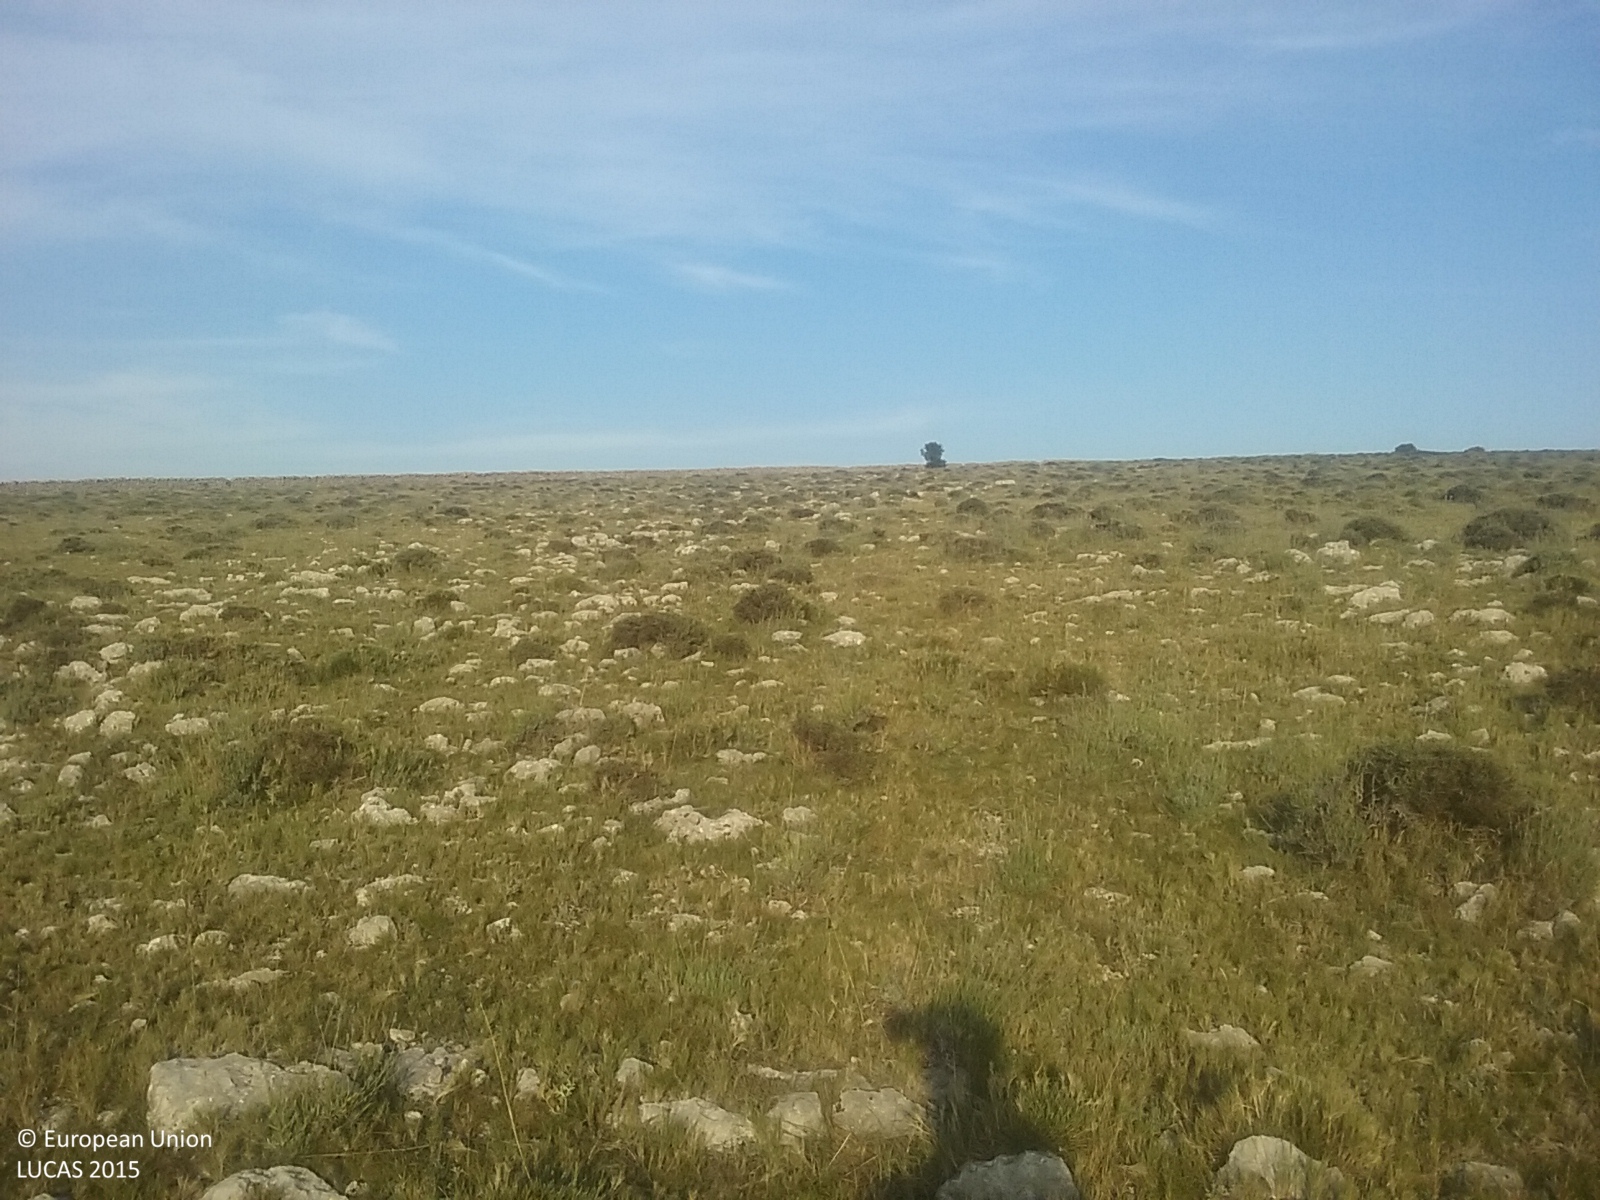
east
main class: Shrubland
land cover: Shrubland without tree cover
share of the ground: 25 - 50 %
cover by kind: herbaceous plants 75 %, shrubs 25 %
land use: Agriculture (excluding fallow land and kitchen gardens)
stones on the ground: 25 - 50 %
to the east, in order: Shrubland without tree cover; Dry stone walls; Shrubland without tree cover
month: August
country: ES
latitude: 40.4972
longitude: -0.0471
